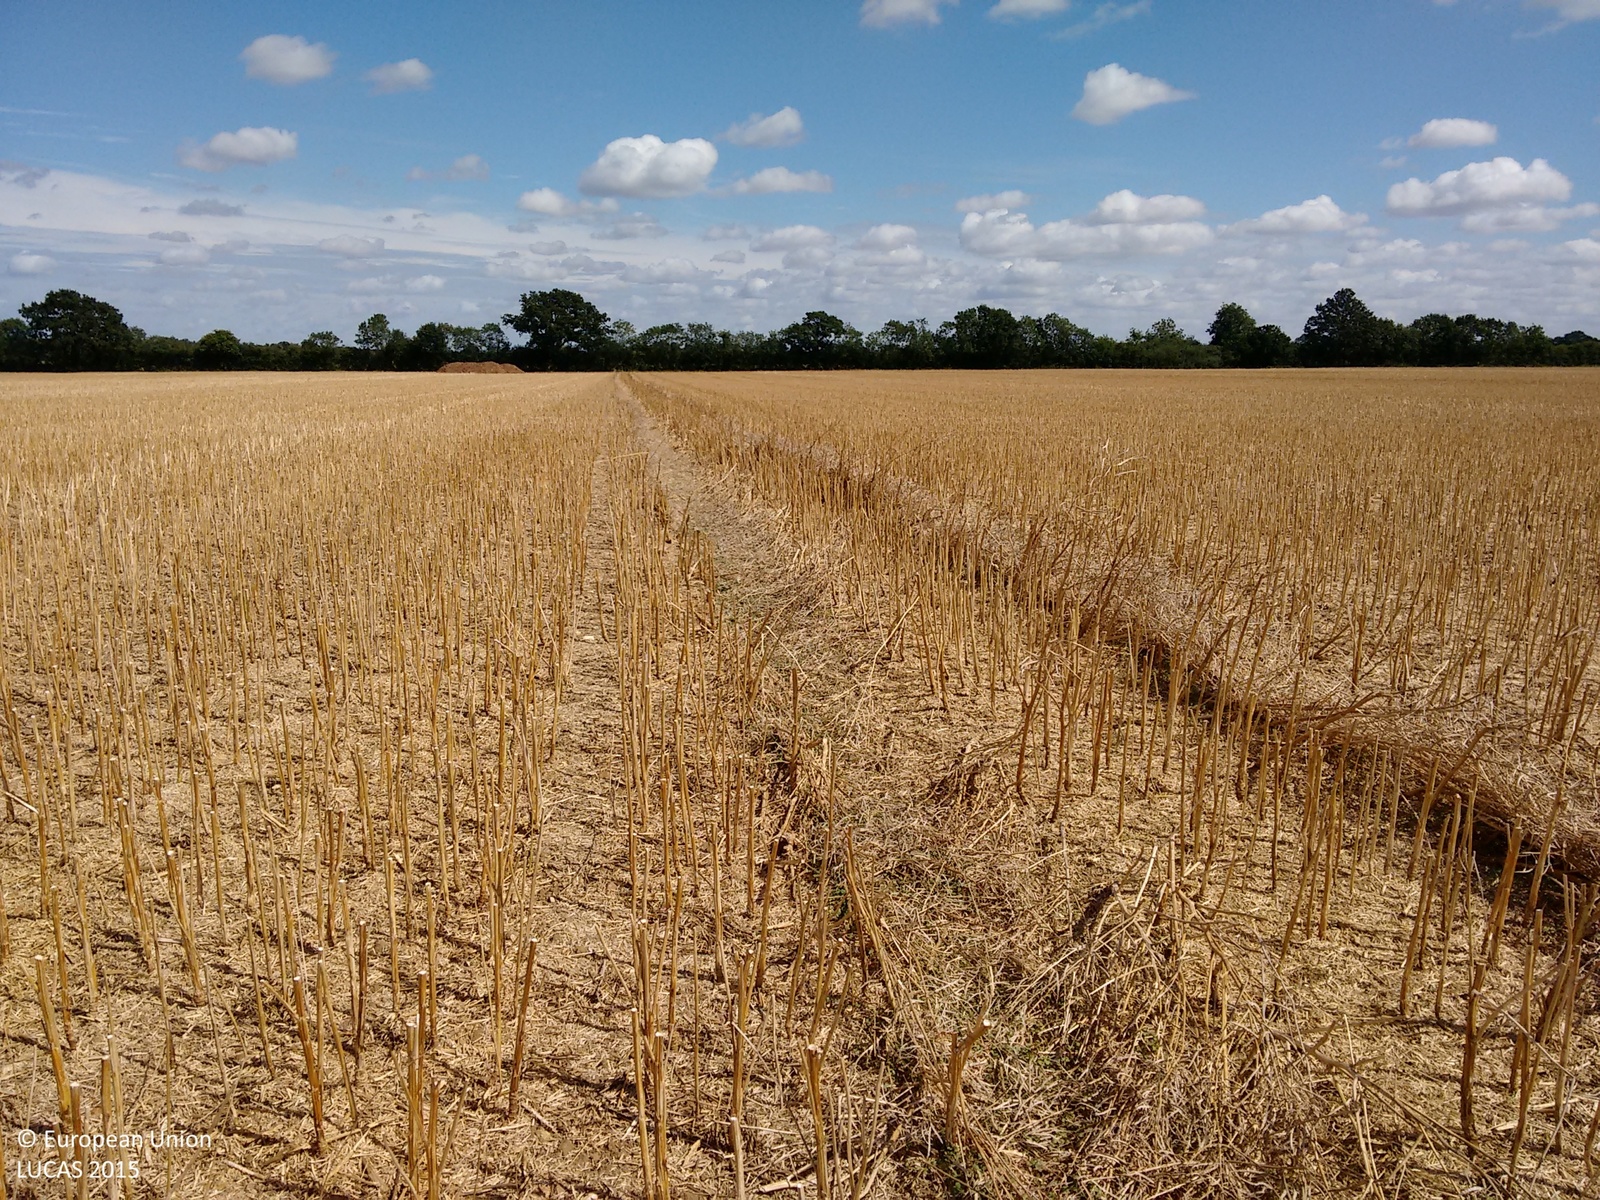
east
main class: Cropland
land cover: Rape and turnip rape
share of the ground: > 75 %
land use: Agriculture (excluding fallow land and kitchen gardens)
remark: Harvested field
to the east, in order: Rape and turnip rape; Grass margins; Tracks; Ditches and canals; Abandoned hedges; Grass margins; Common wheat
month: August
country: GB
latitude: 52.7106
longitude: 0.8431
